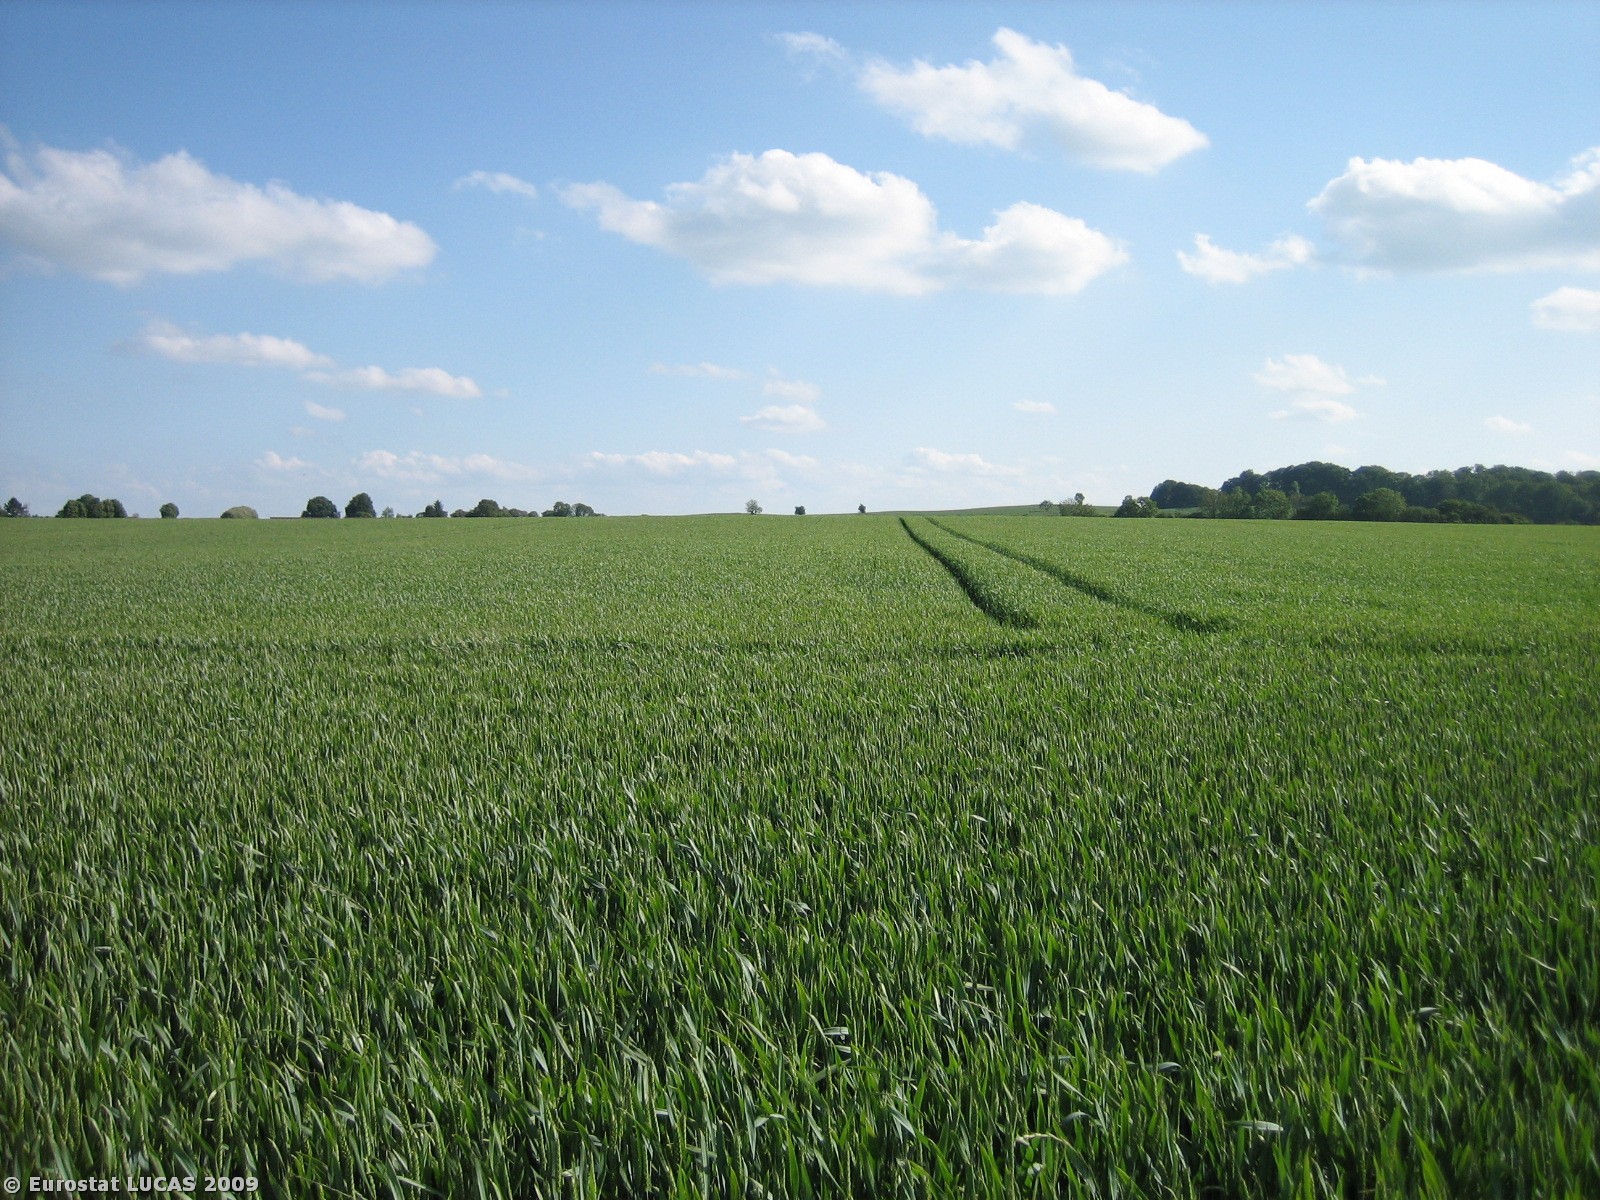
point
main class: Cropland
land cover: Common wheat
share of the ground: > 75 %
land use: Agriculture (excluding fallow land and kitchen gardens)
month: June
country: DK
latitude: 55.8102
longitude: 9.9203
